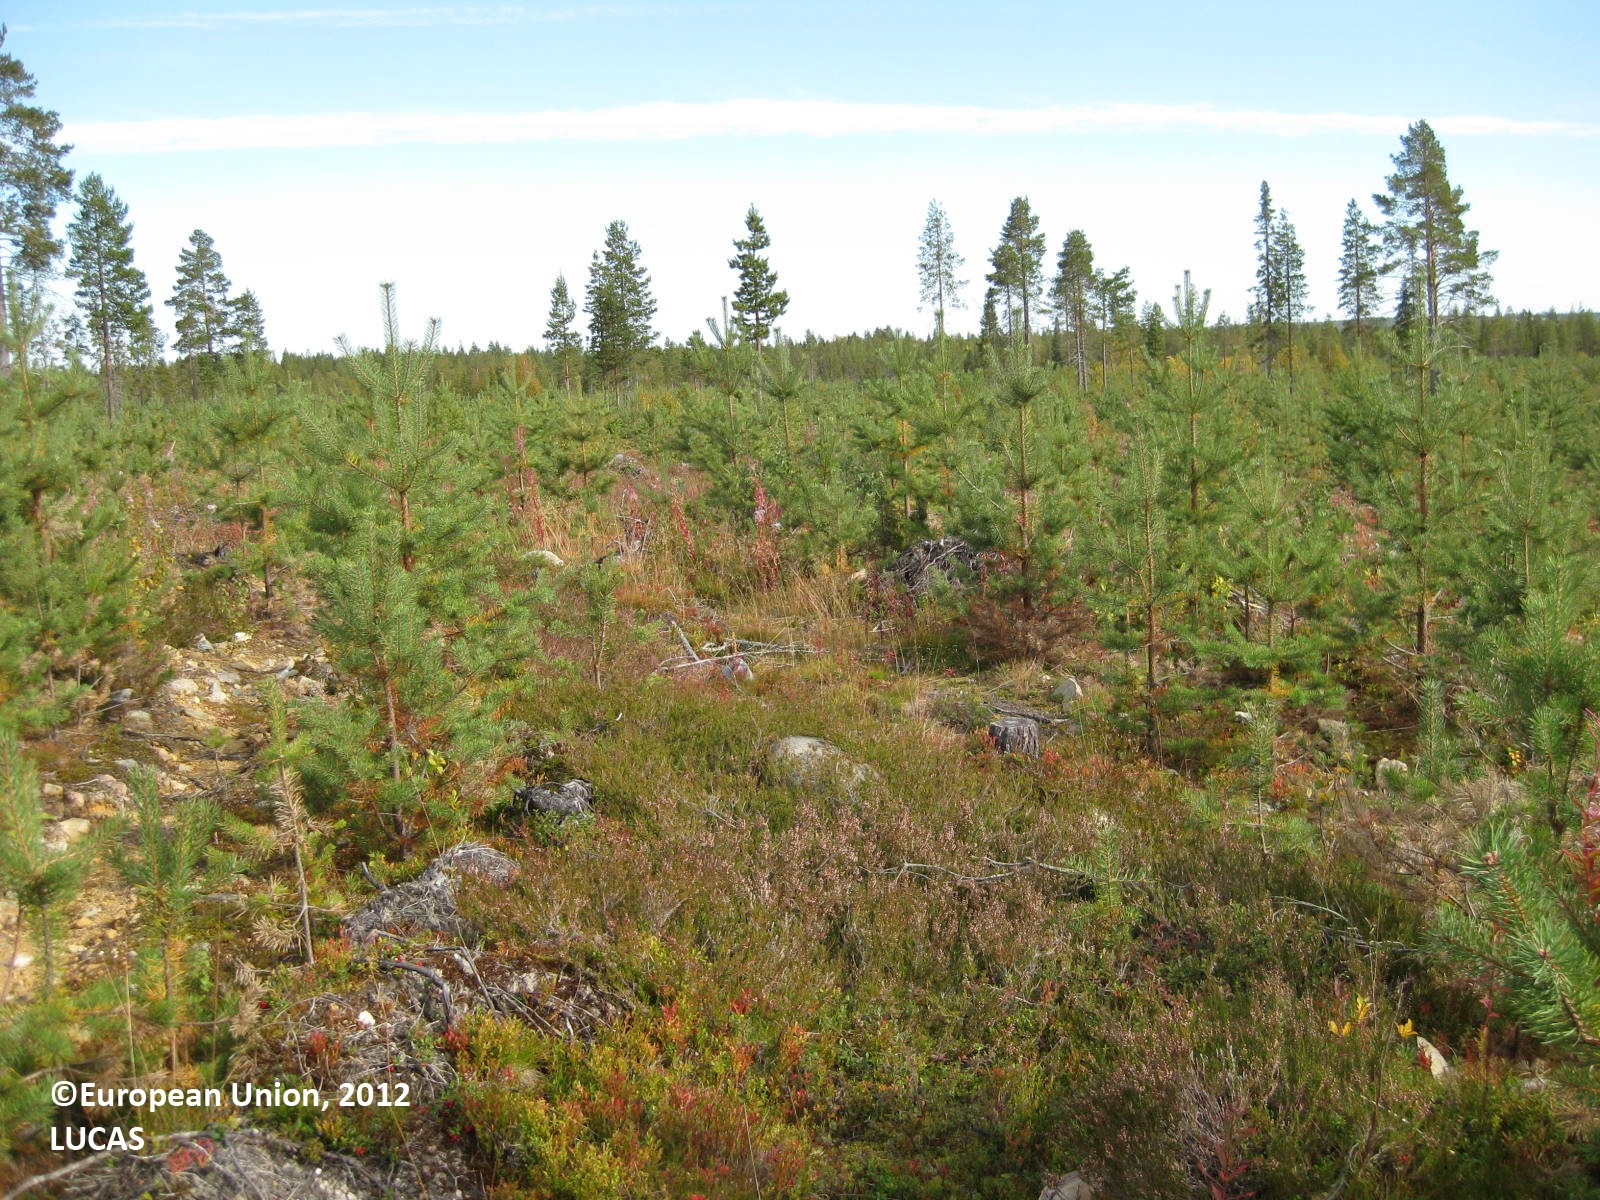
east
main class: Woodland
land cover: Pine dominated coniferous woodland
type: boreal forest
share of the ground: 50 - 75 %
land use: Forestry
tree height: < 5 m
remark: Clear cut
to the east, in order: Pine dominated coniferous woodland; Ditches and canals; Pine dominated coniferous woodland; Ditches and canals; Pine dominated coniferous woodland; Ditches and canals; Pine dominated coniferous woodland; Ditches and canals; Pine dominated coniferous woodland; Ditches and canals; Pine dominated coniferous woodland; Ditches and canals; Pine dominated coniferous woodland; Ditches and canals; Pine dominated coniferous woodland; Ditches and canals; Pine dominated coniferous woodland; Ditches and canals
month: August
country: FI
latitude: 65.8890
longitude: 28.7002
